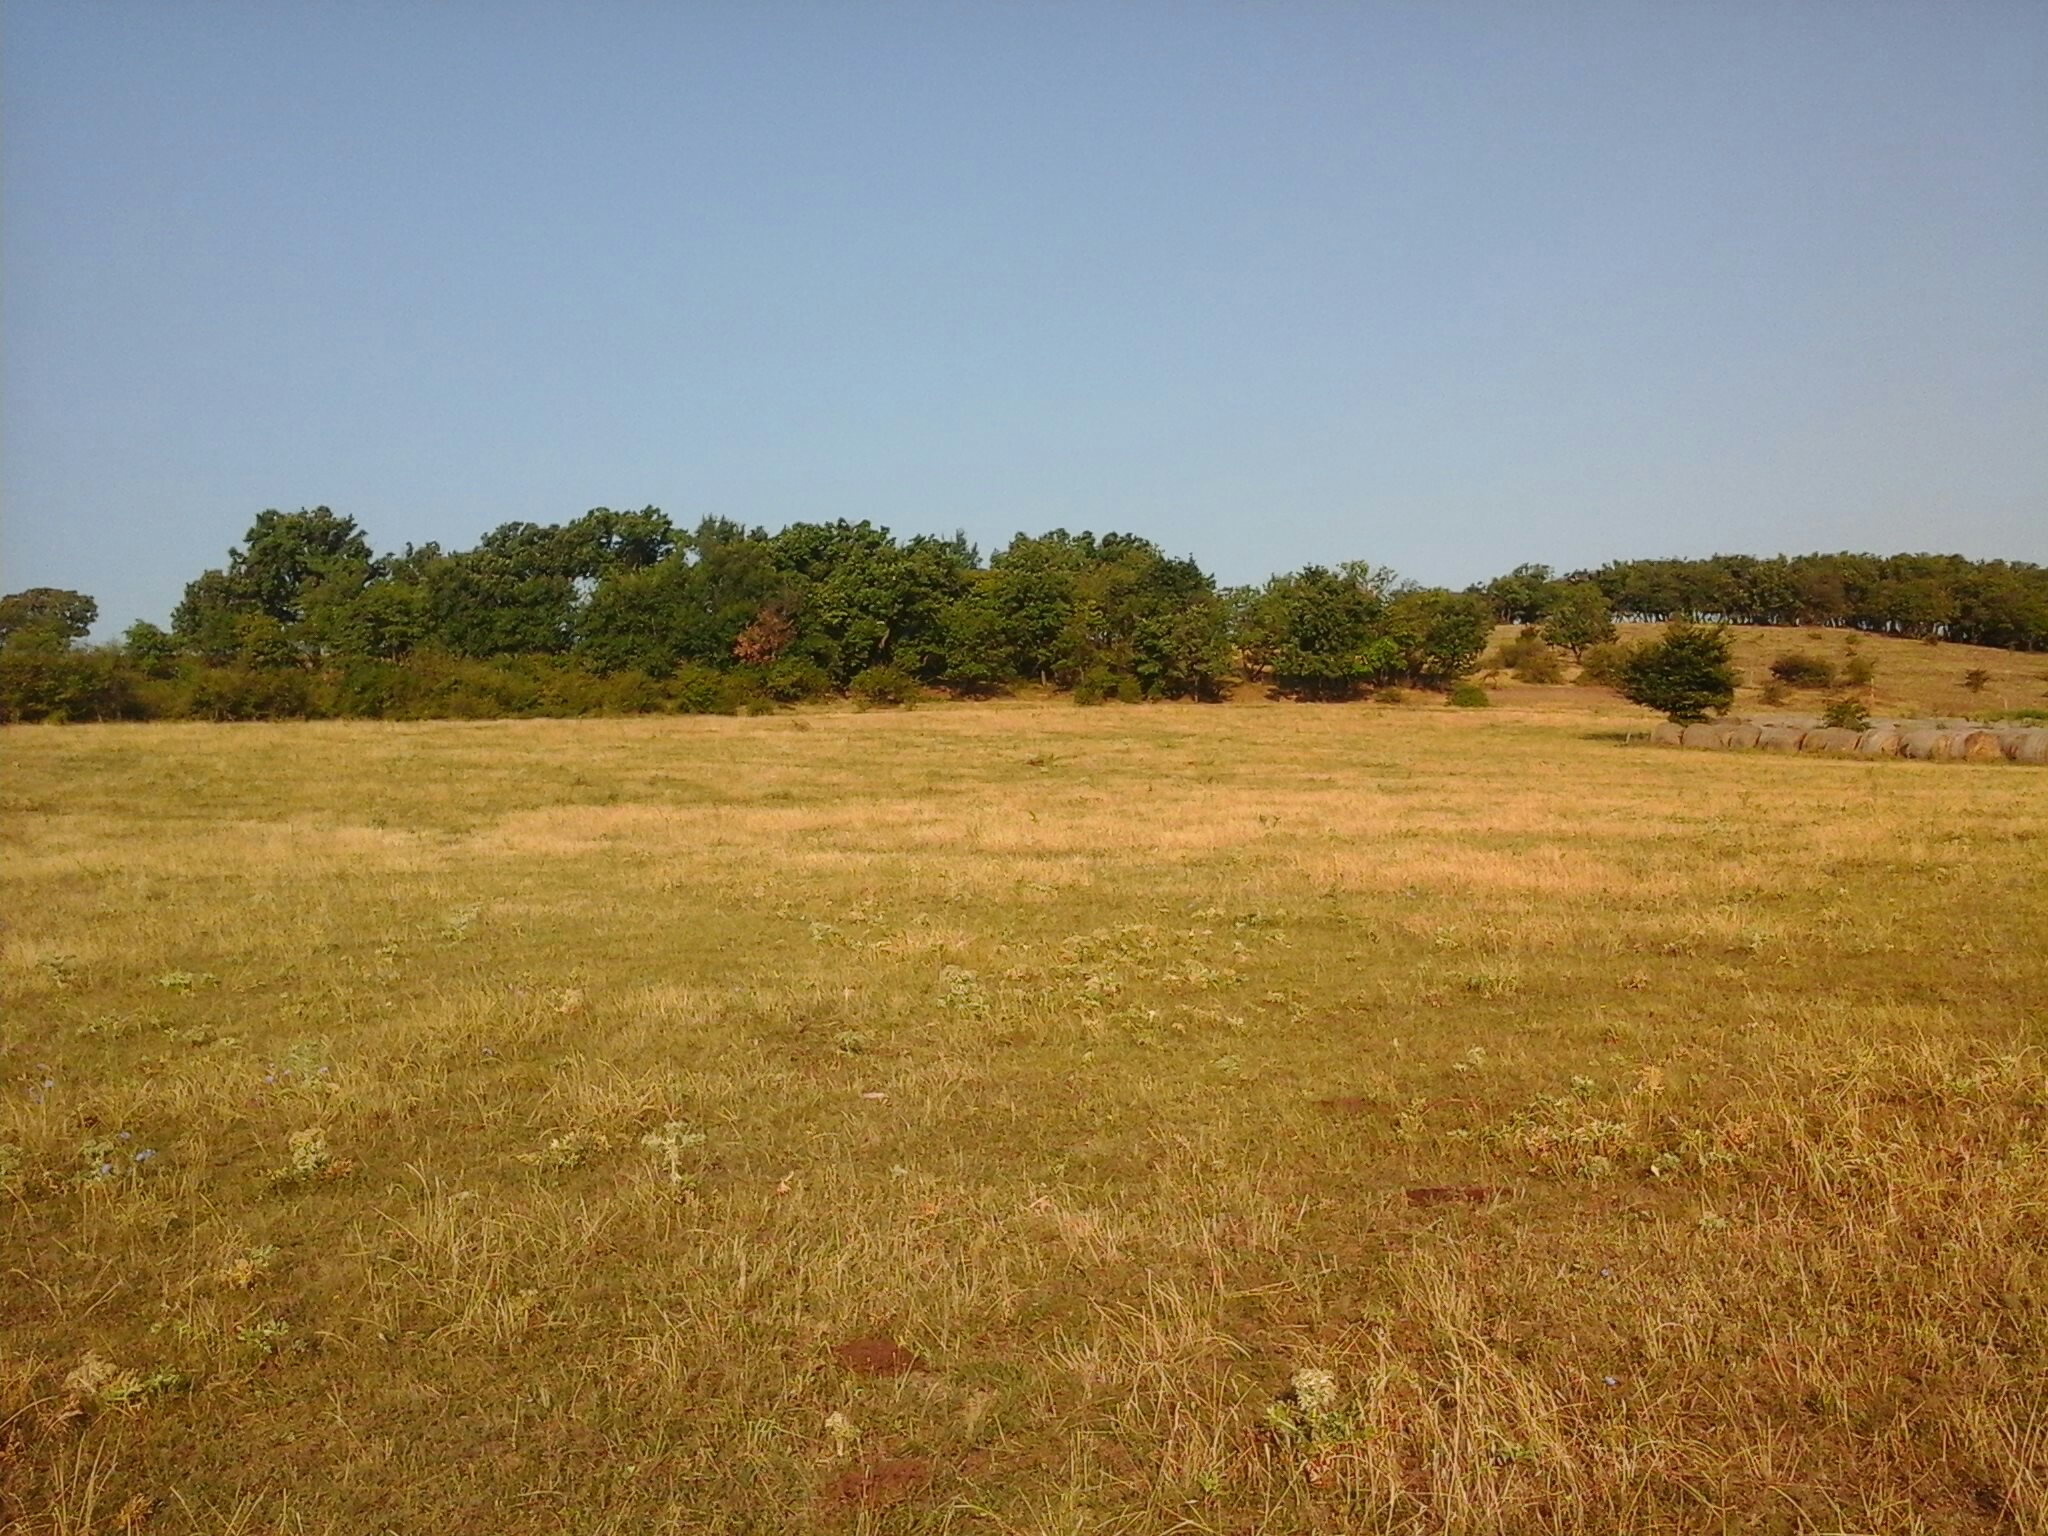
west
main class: Grassland
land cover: Grassland without tree/shrub cover
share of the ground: > 75 %
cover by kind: herbaceous plants 100 %
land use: Agriculture (excluding fallow land and kitchen gardens)
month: August
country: HU
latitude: 47.2432
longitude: 18.2684
